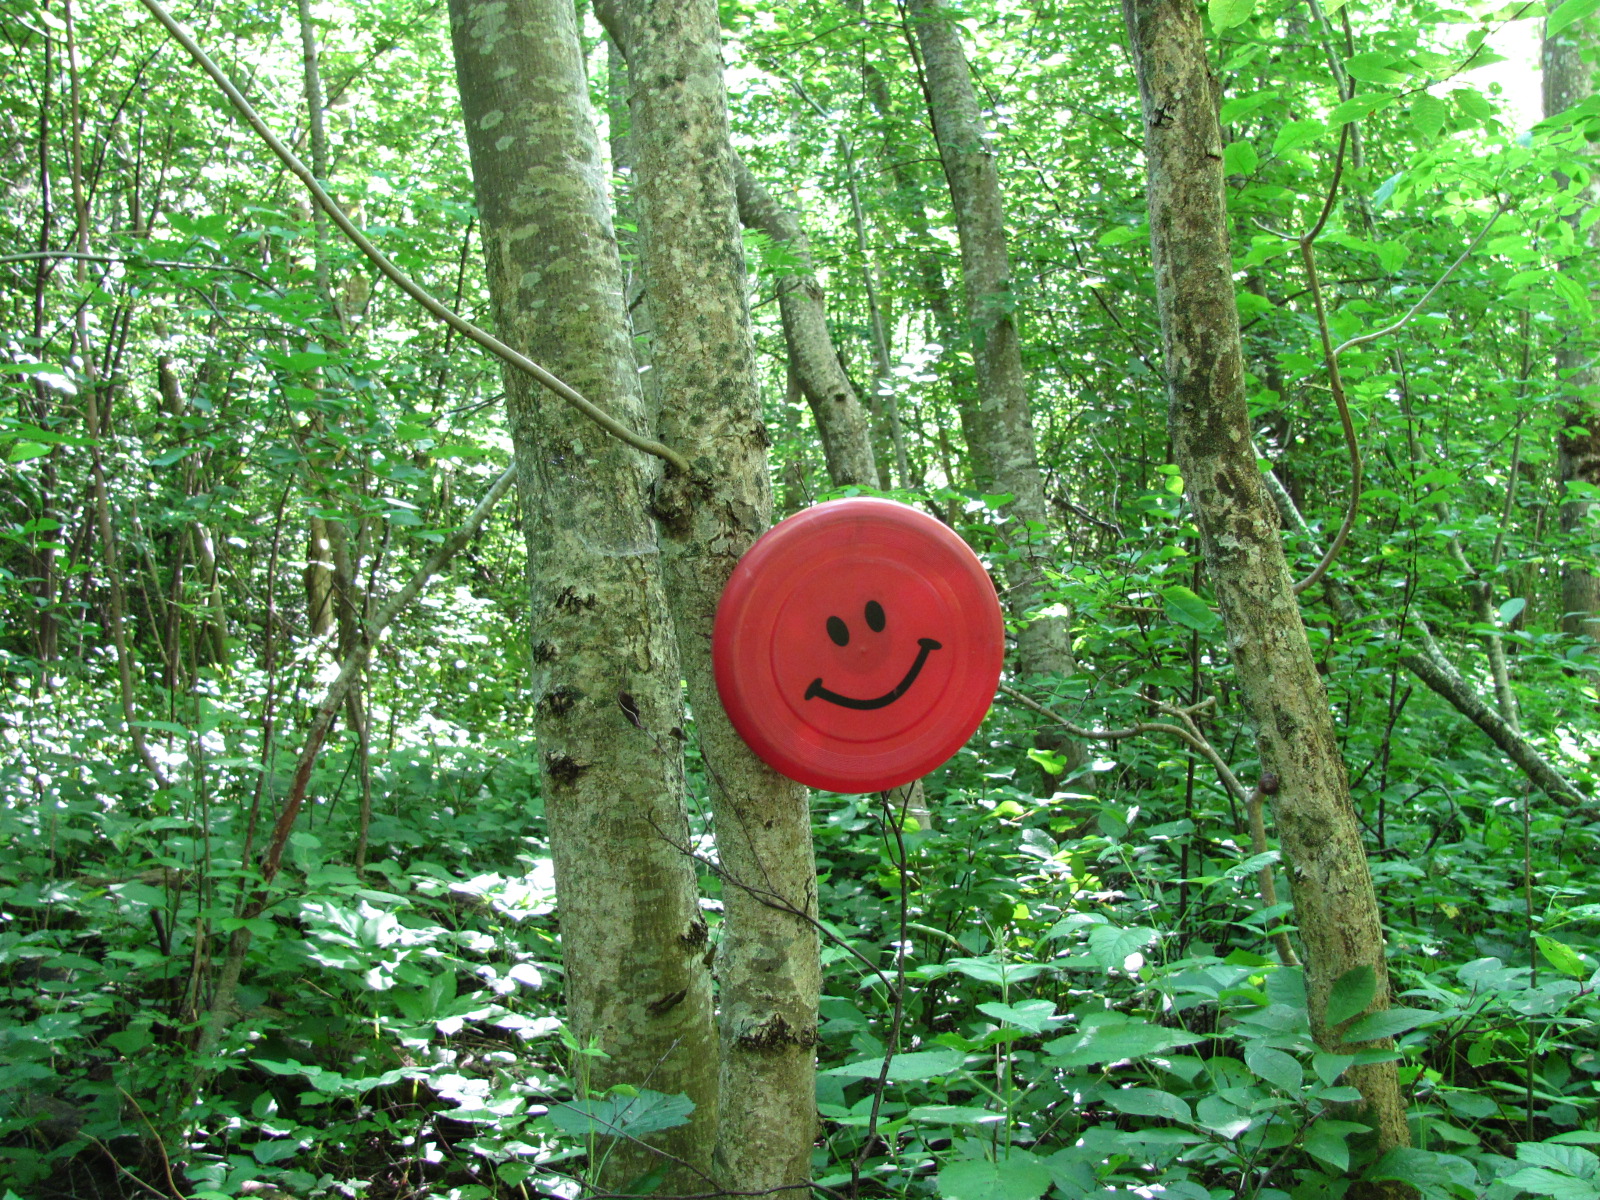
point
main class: Woodland
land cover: Broadleaved woodland
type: non-riverine alder, birch or aspen forest
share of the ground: > 75 %
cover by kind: broadleaved forest trees 100 %
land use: Forestry
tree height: > 5 m
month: June
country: LV
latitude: 56.3526
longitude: 23.9532
